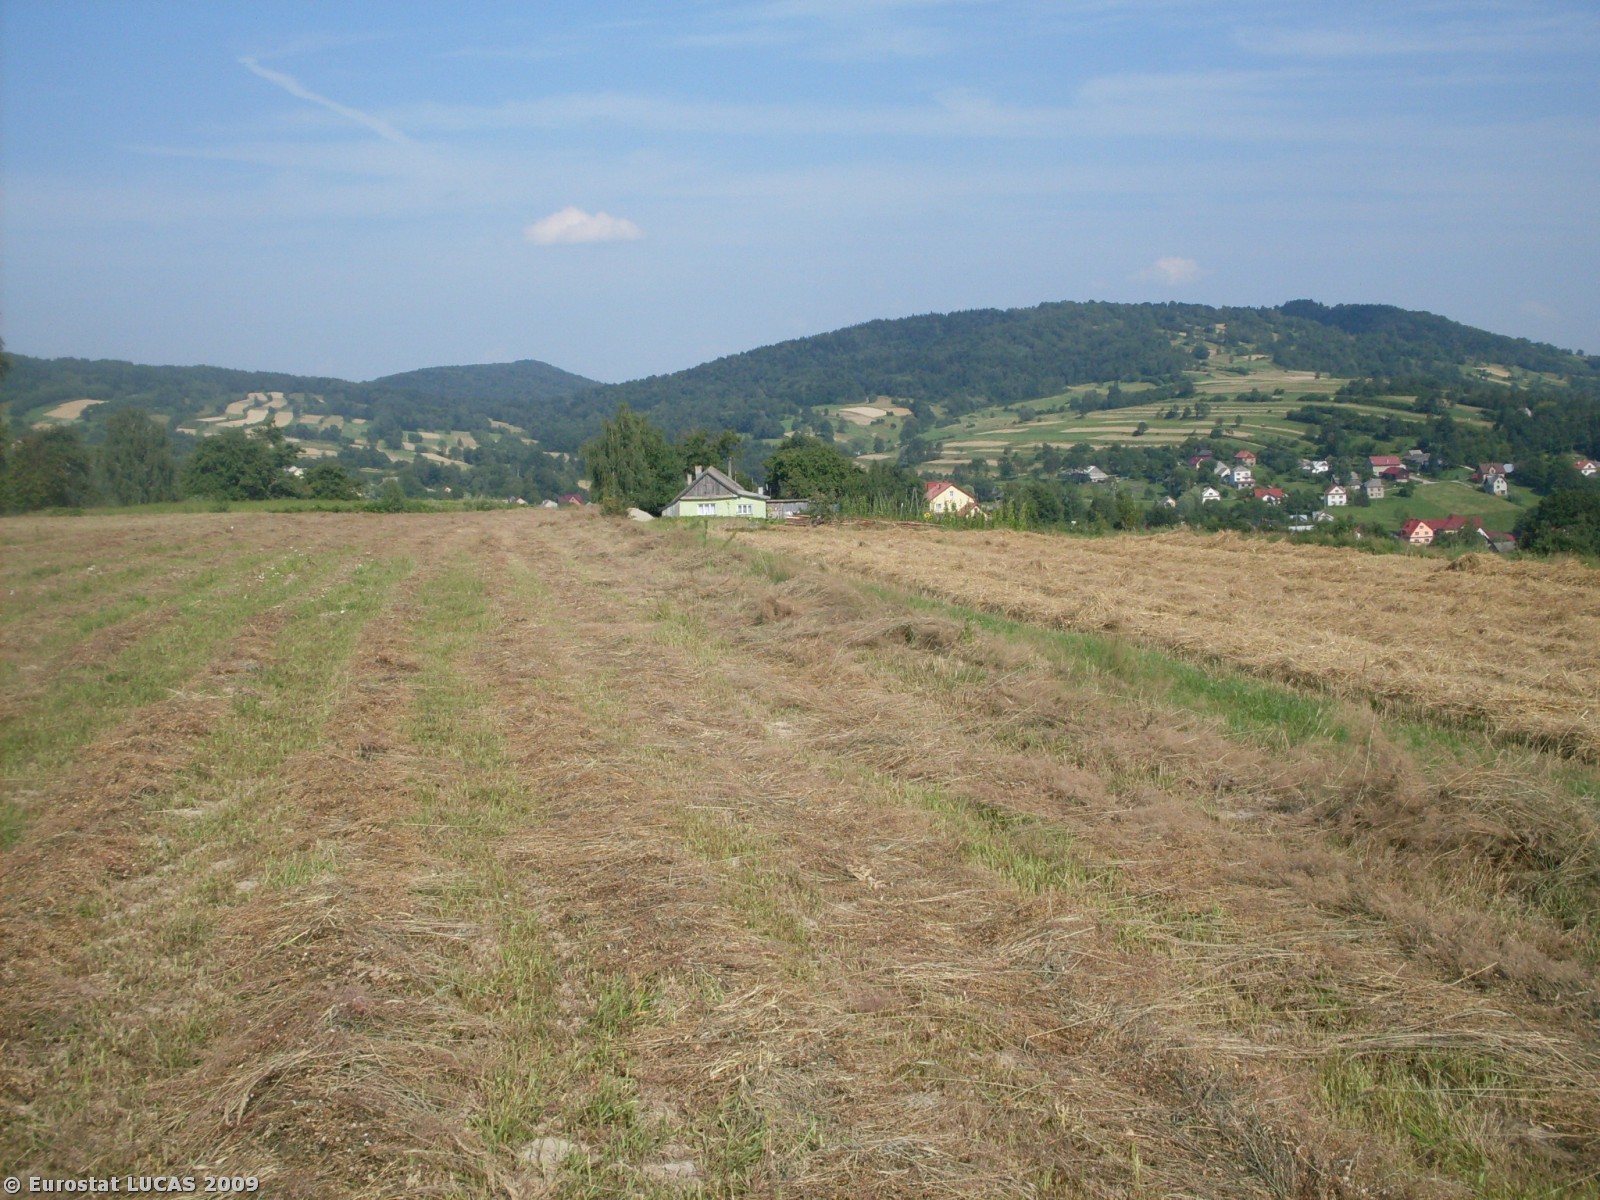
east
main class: Grassland
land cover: Grassland without tree/shrub cover
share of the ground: > 75 %
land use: Agriculture (excluding fallow land and kitchen gardens)
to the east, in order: Grassland without tree/shrub cover; Potatoes; Grass margins; Artificial constructions in urban areas; Electric lines; Grassland with sparse tree/shrub cover; Fences; Grassland without tree/shrub cover; Single bushes/trees; Grassland without tree/shrub cover
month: July
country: PL
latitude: 49.8271
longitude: 20.4769
